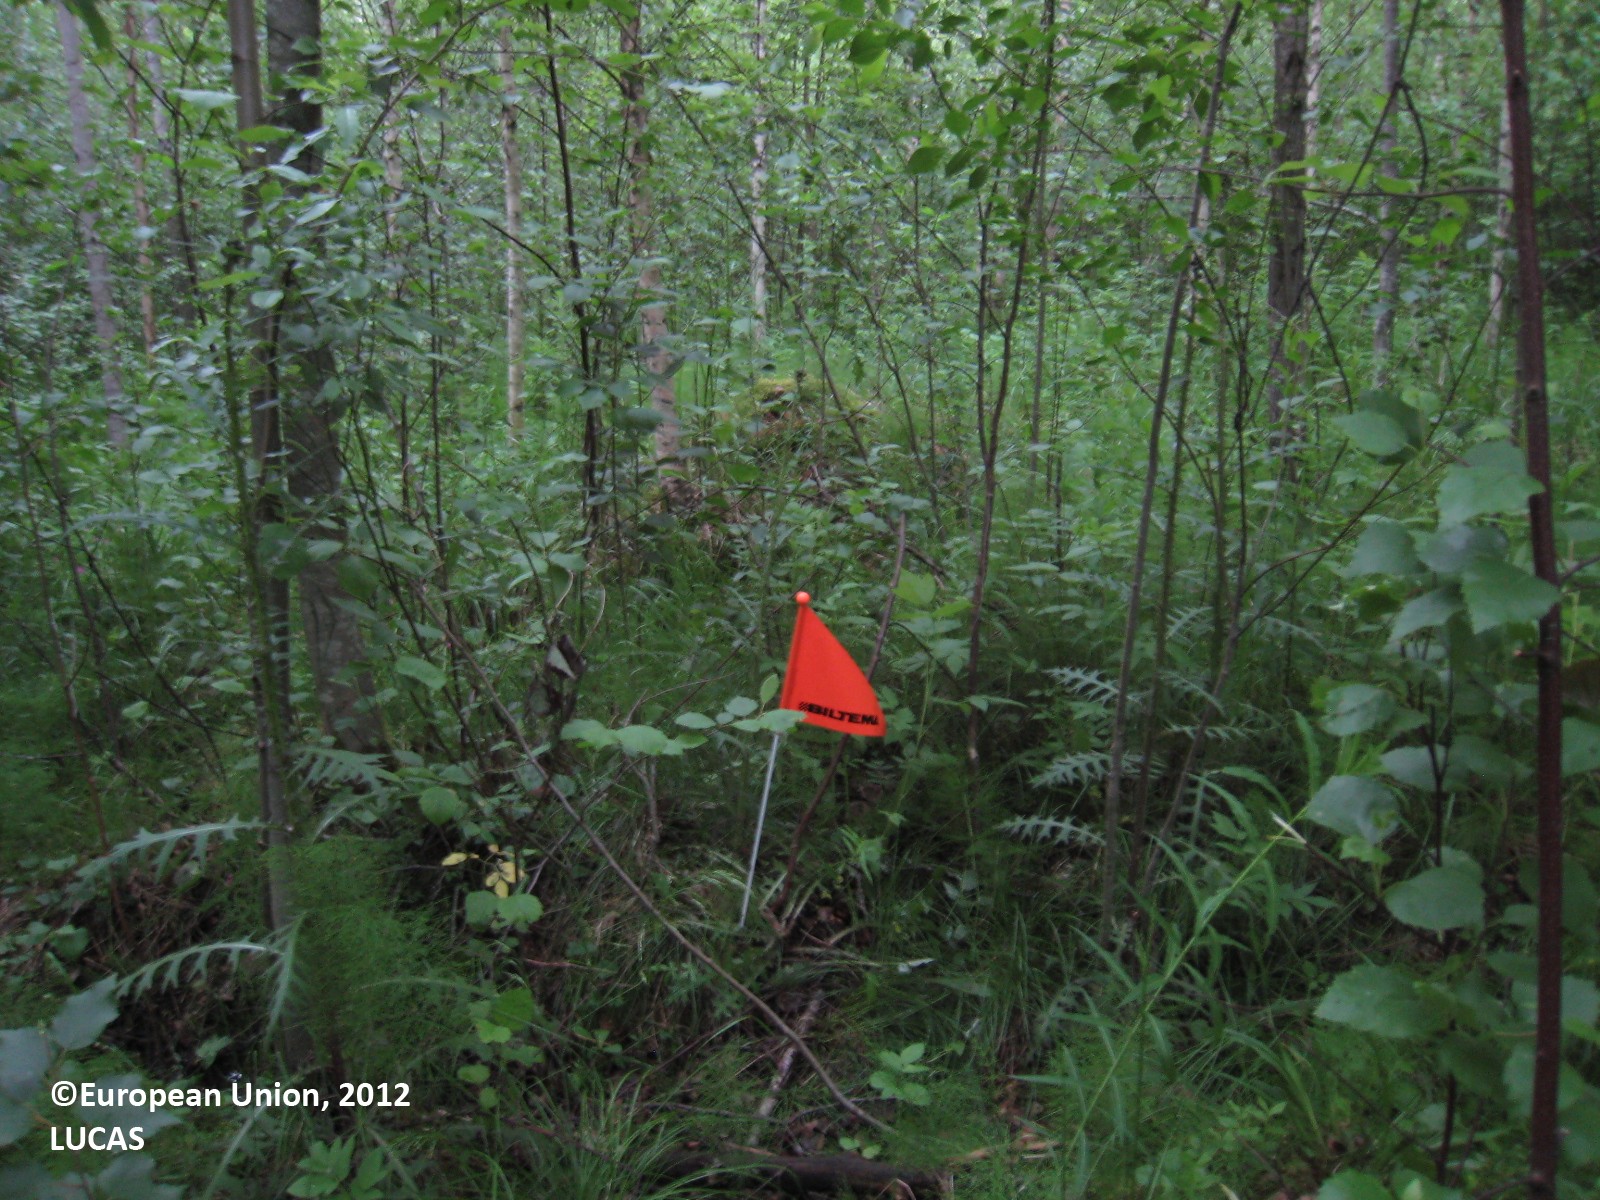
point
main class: Woodland
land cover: Broadleaved woodland
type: non-riverine alder, birch or aspen forest
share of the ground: > 75 %
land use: Forestry
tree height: > 5 m
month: June
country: FI
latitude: 62.4114
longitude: 26.0161
